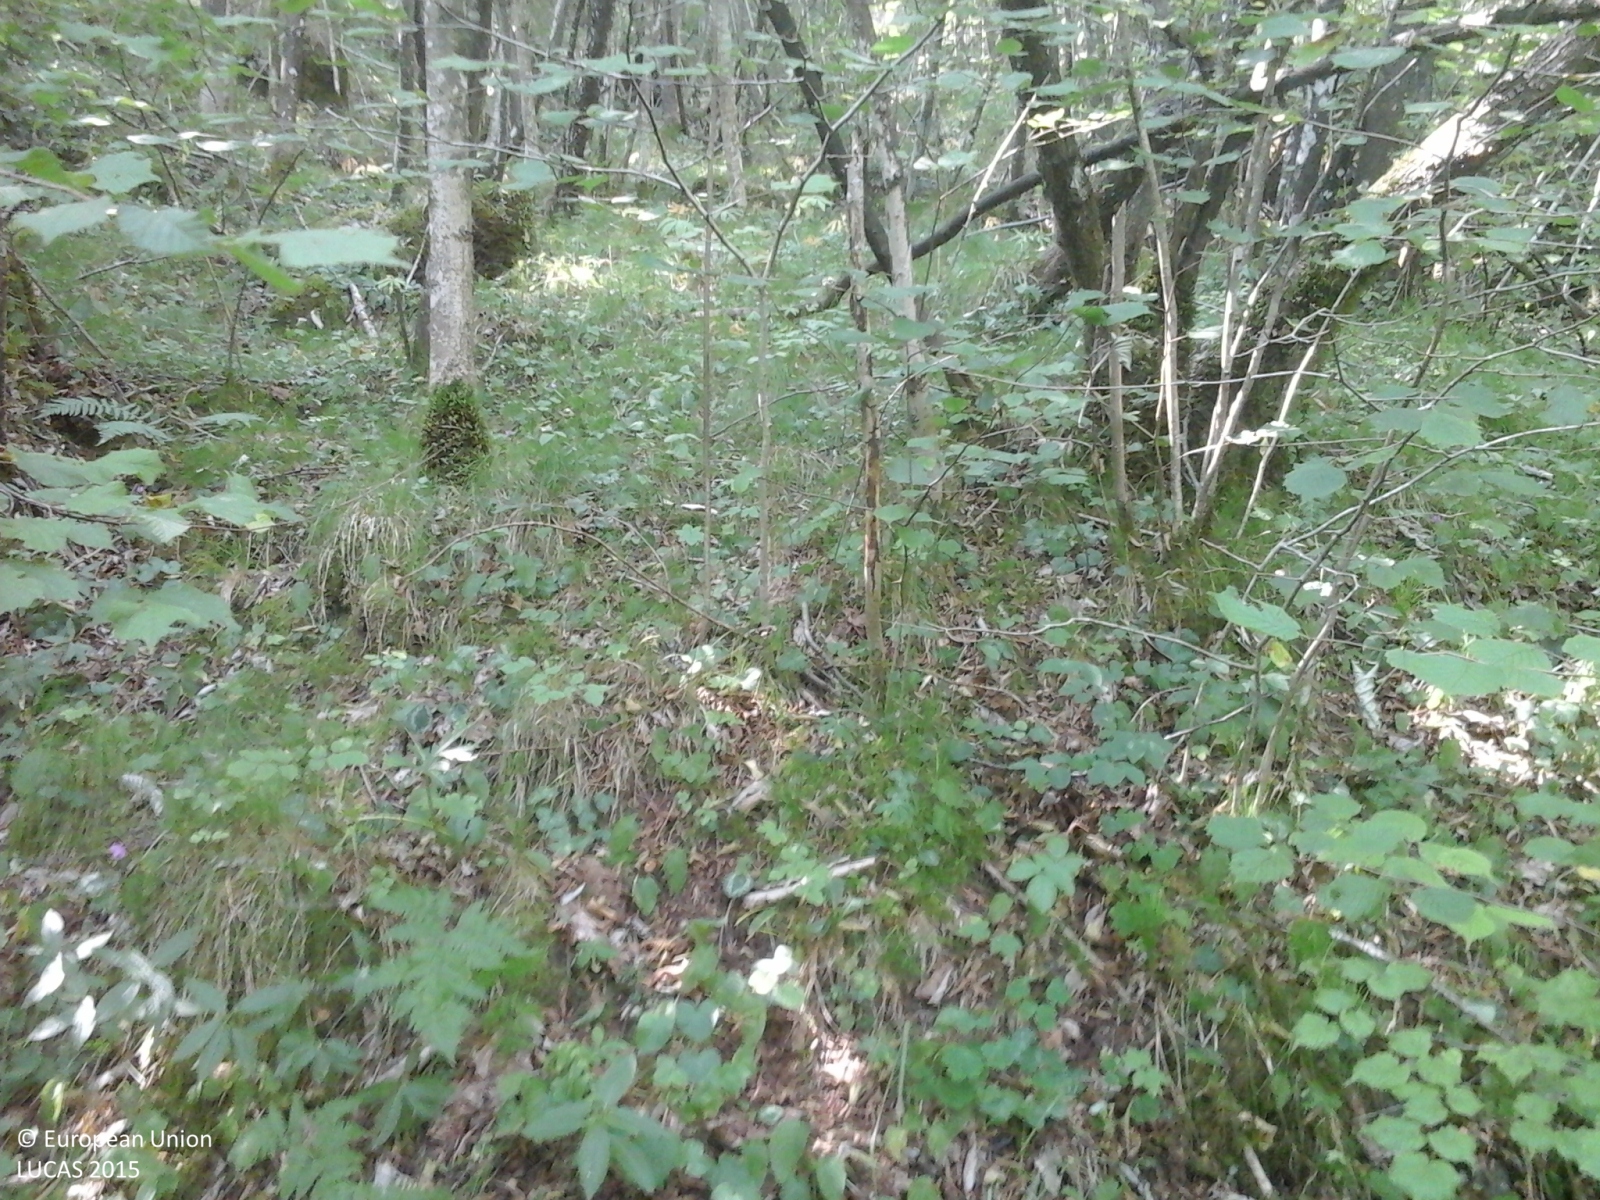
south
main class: Woodland
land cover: Broadleaved woodland
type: thermophilous deciduous forest
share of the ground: > 75 %
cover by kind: broadleaved forest trees 100 %
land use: Forestry
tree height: > 5 m
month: July
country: IT
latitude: 45.8822
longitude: 9.6269
